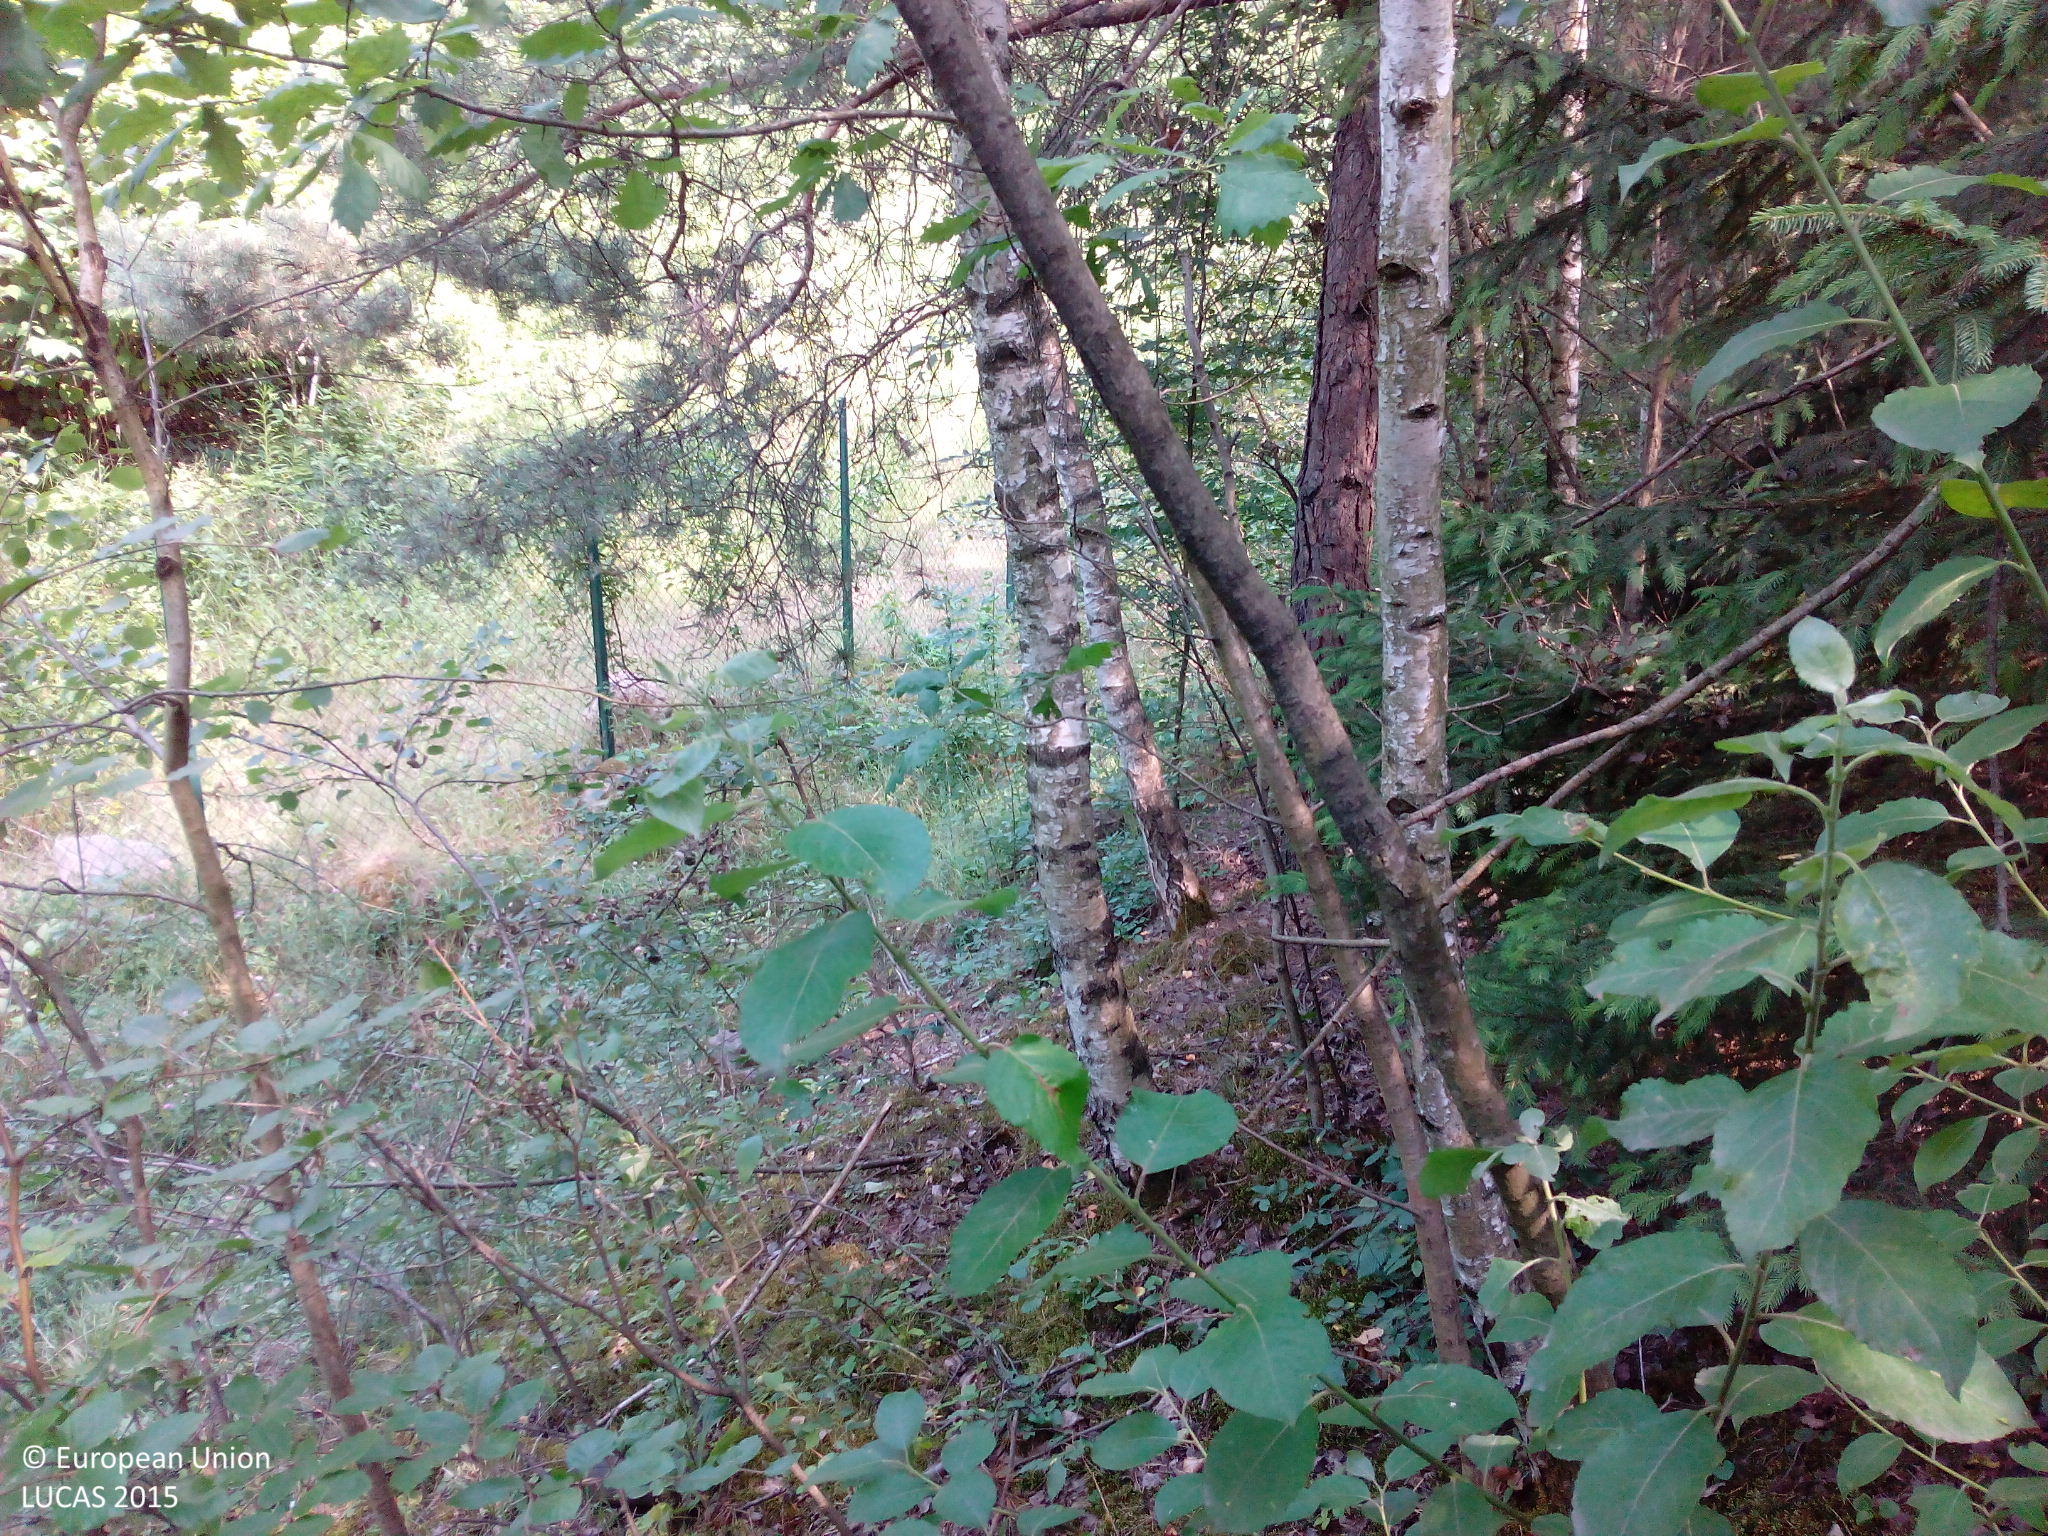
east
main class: Woodland
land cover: Other mixed woodland
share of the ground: > 75 %
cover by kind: coniferous forest trees 75 %, broadleaved forest trees 25 %
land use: Semi-natural and natural areas not in use
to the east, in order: Other mixed woodland; Grass margins; Fences; Grass margins; Shrubland with sparse tree cover; Broadleaved woodland; Shrubland without tree cover; Tracks; Shrubland without tree cover; Broadleaved woodland; Inland fresh running water; Grassland without tree/shrub cover; Paved roads, cycling and walking lanes; Grass margins
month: July
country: DE
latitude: 49.3389
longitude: 7.1515
